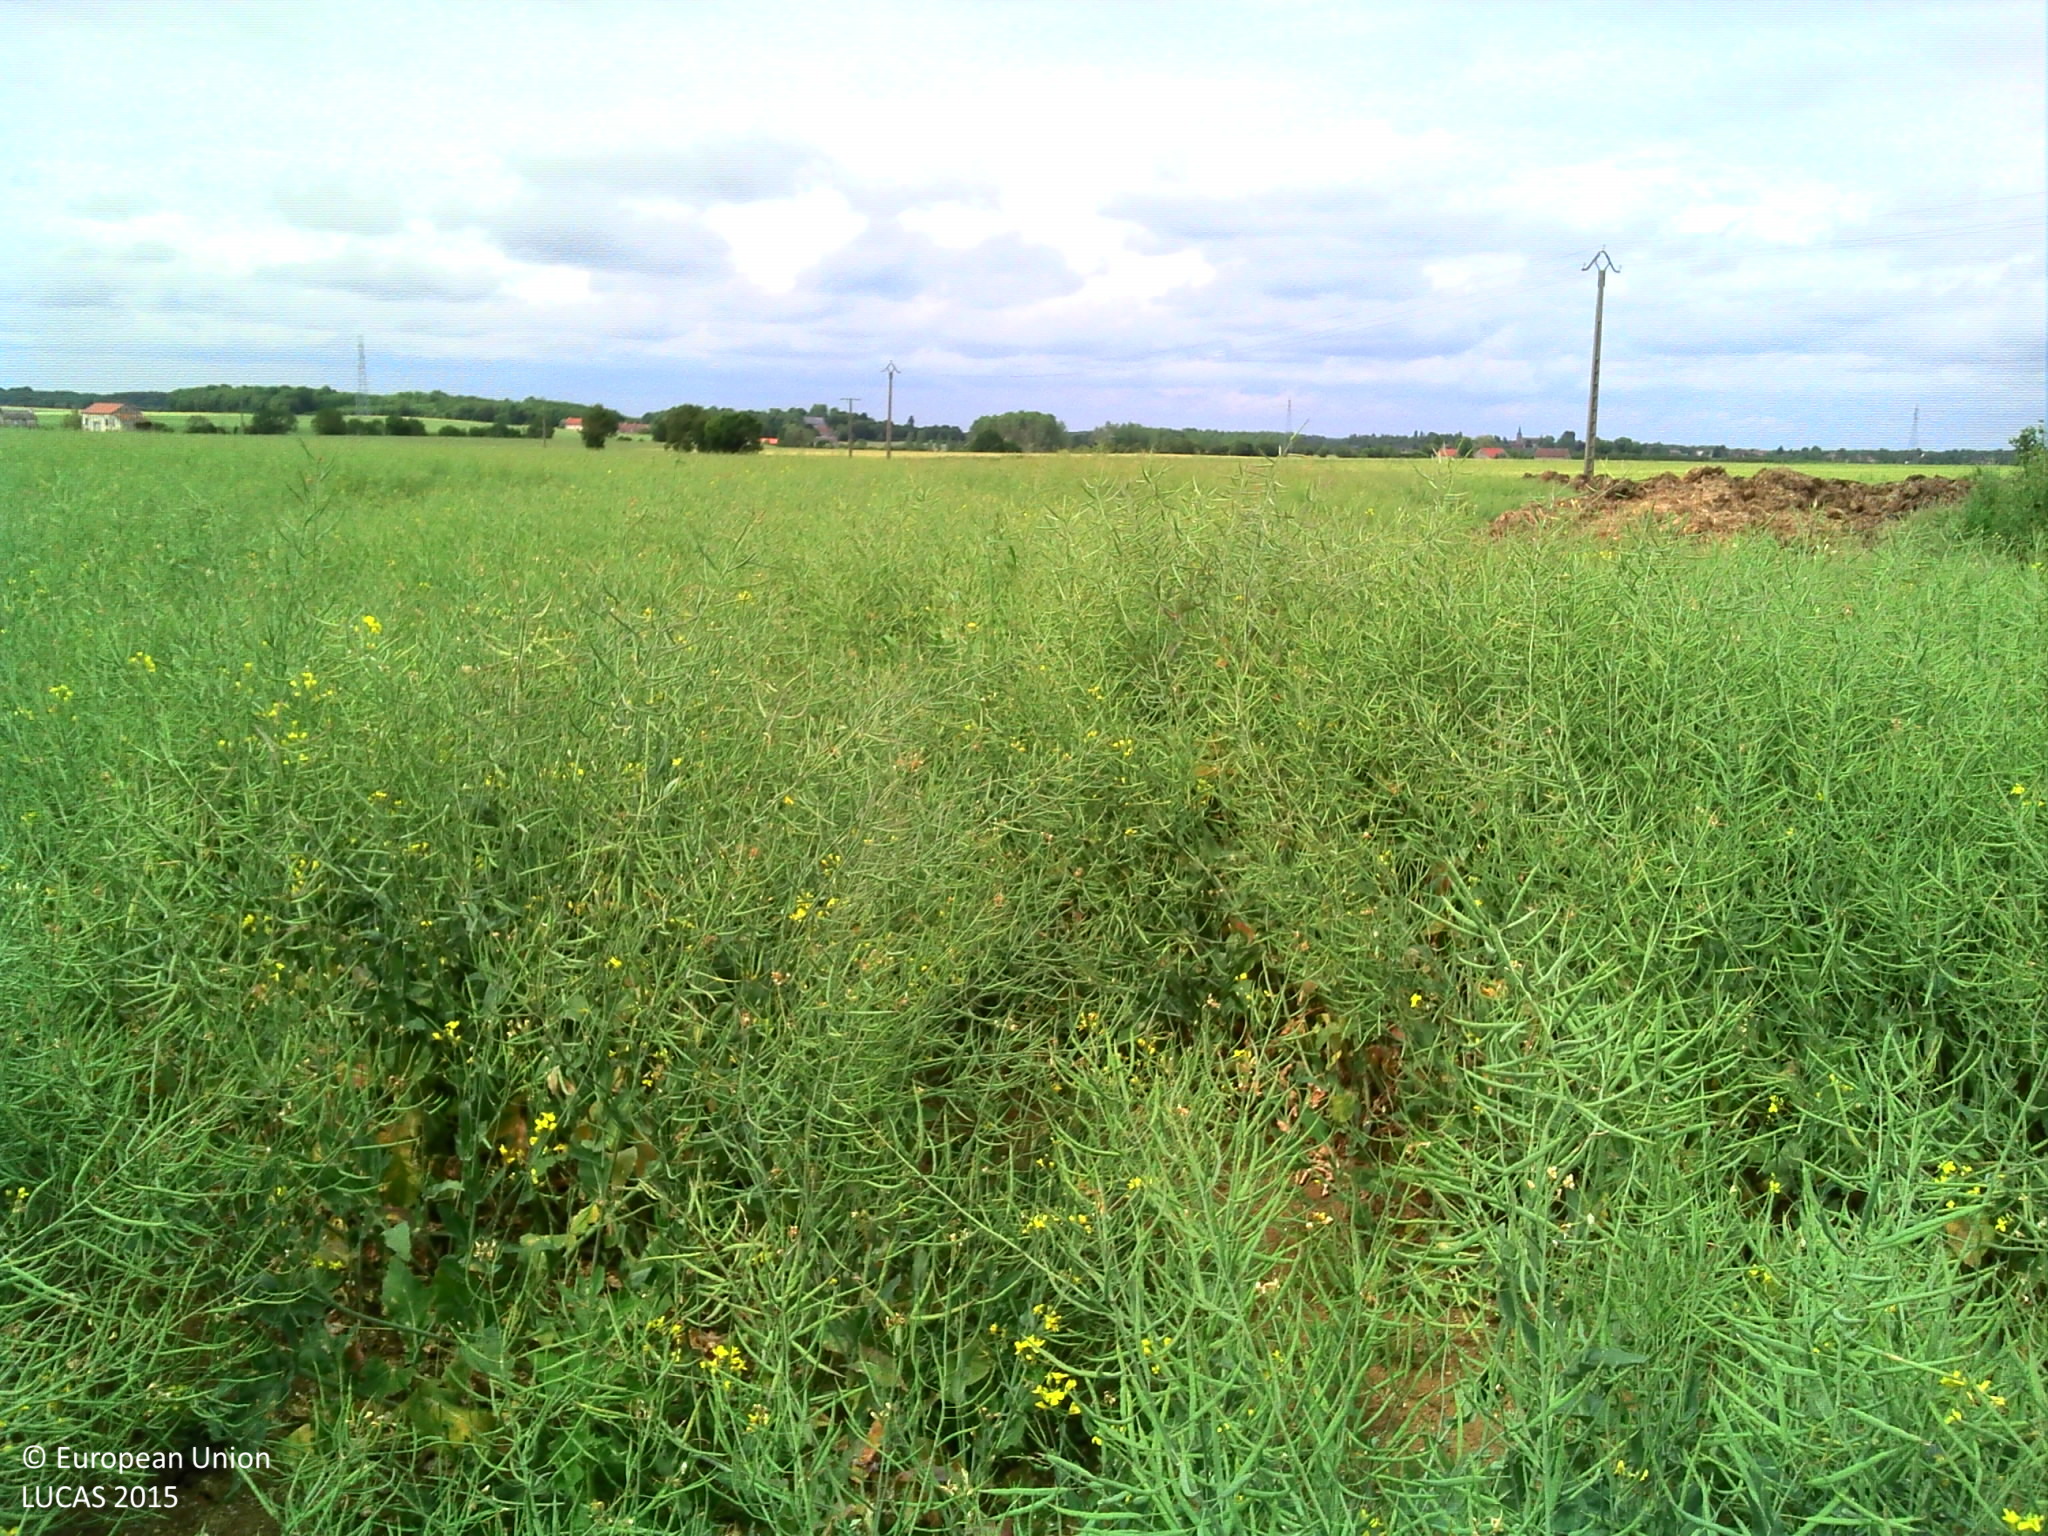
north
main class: Cropland
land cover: Rape and turnip rape
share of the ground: > 75 %
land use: Agriculture (excluding fallow land and kitchen gardens)
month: May
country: FR
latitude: 47.1104
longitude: 2.9183
